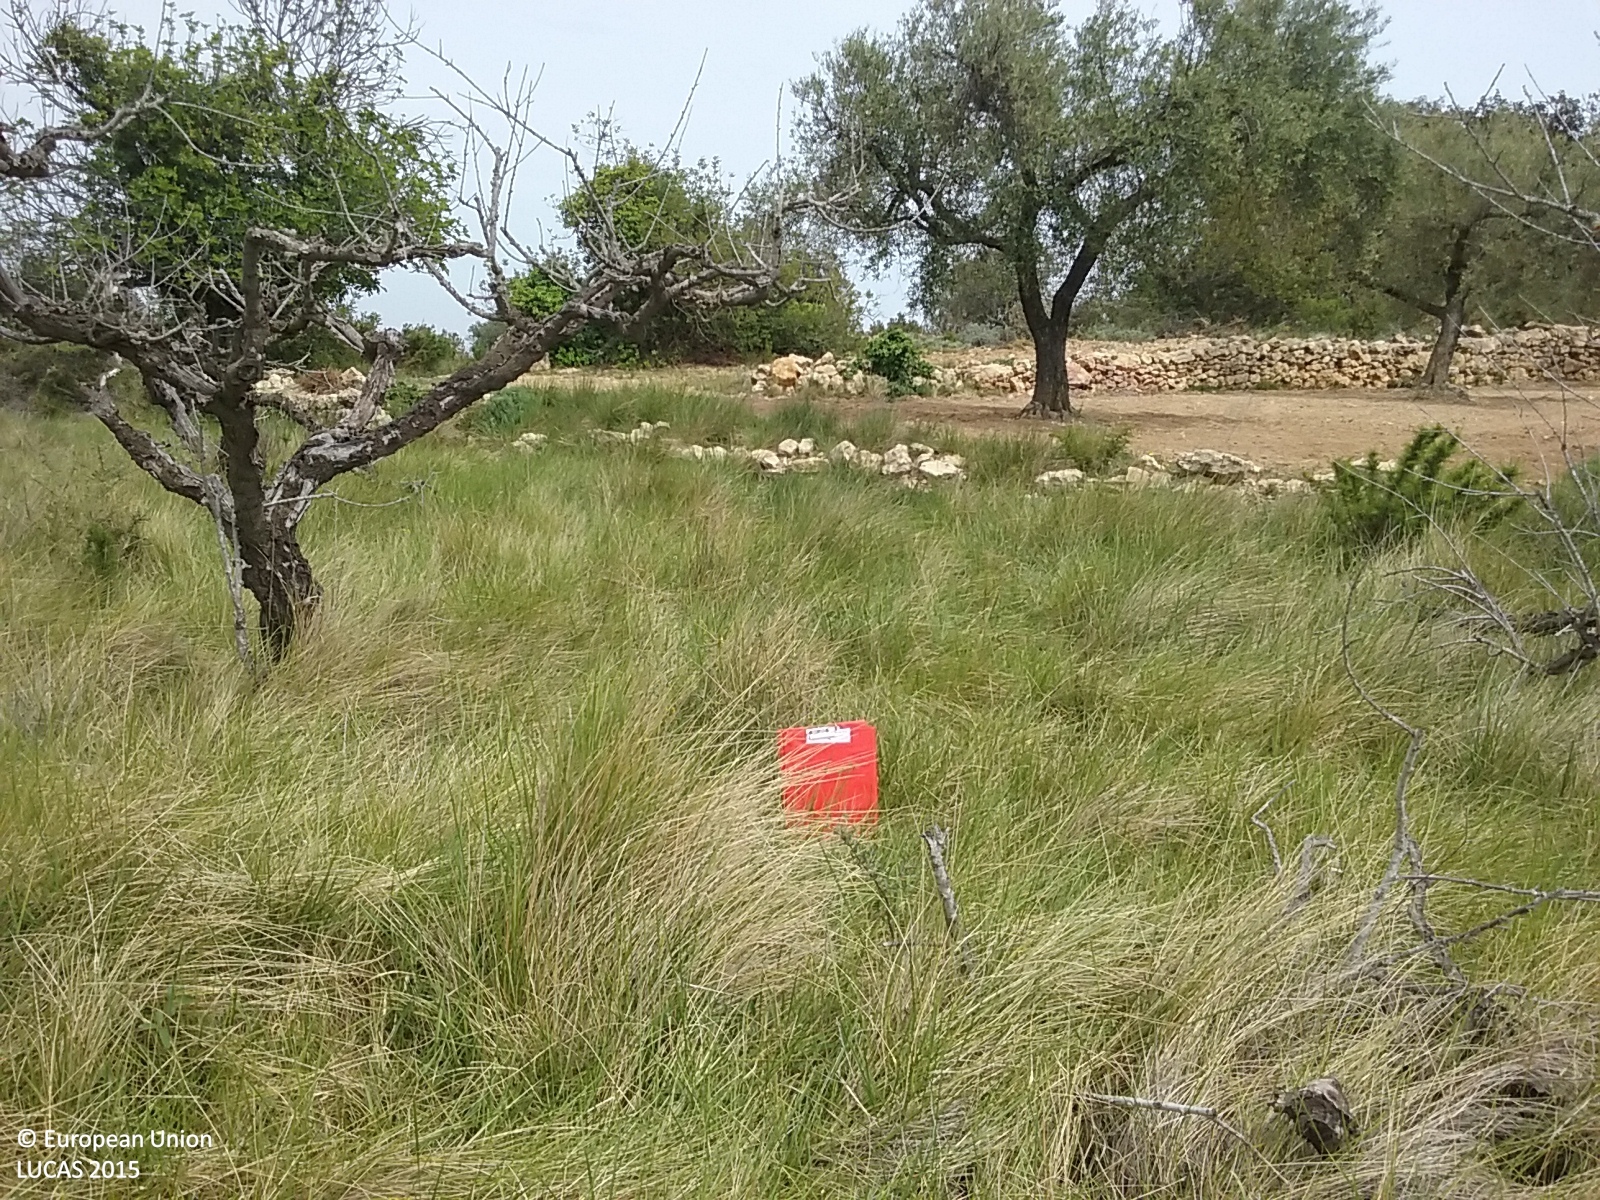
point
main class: Cropland
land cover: Cherry fruit
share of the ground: < 10 %
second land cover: Grassland without tree/shrub cover
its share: > 75 %
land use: Abandoned areas
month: April
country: ES
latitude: 40.5099
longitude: 0.2592
